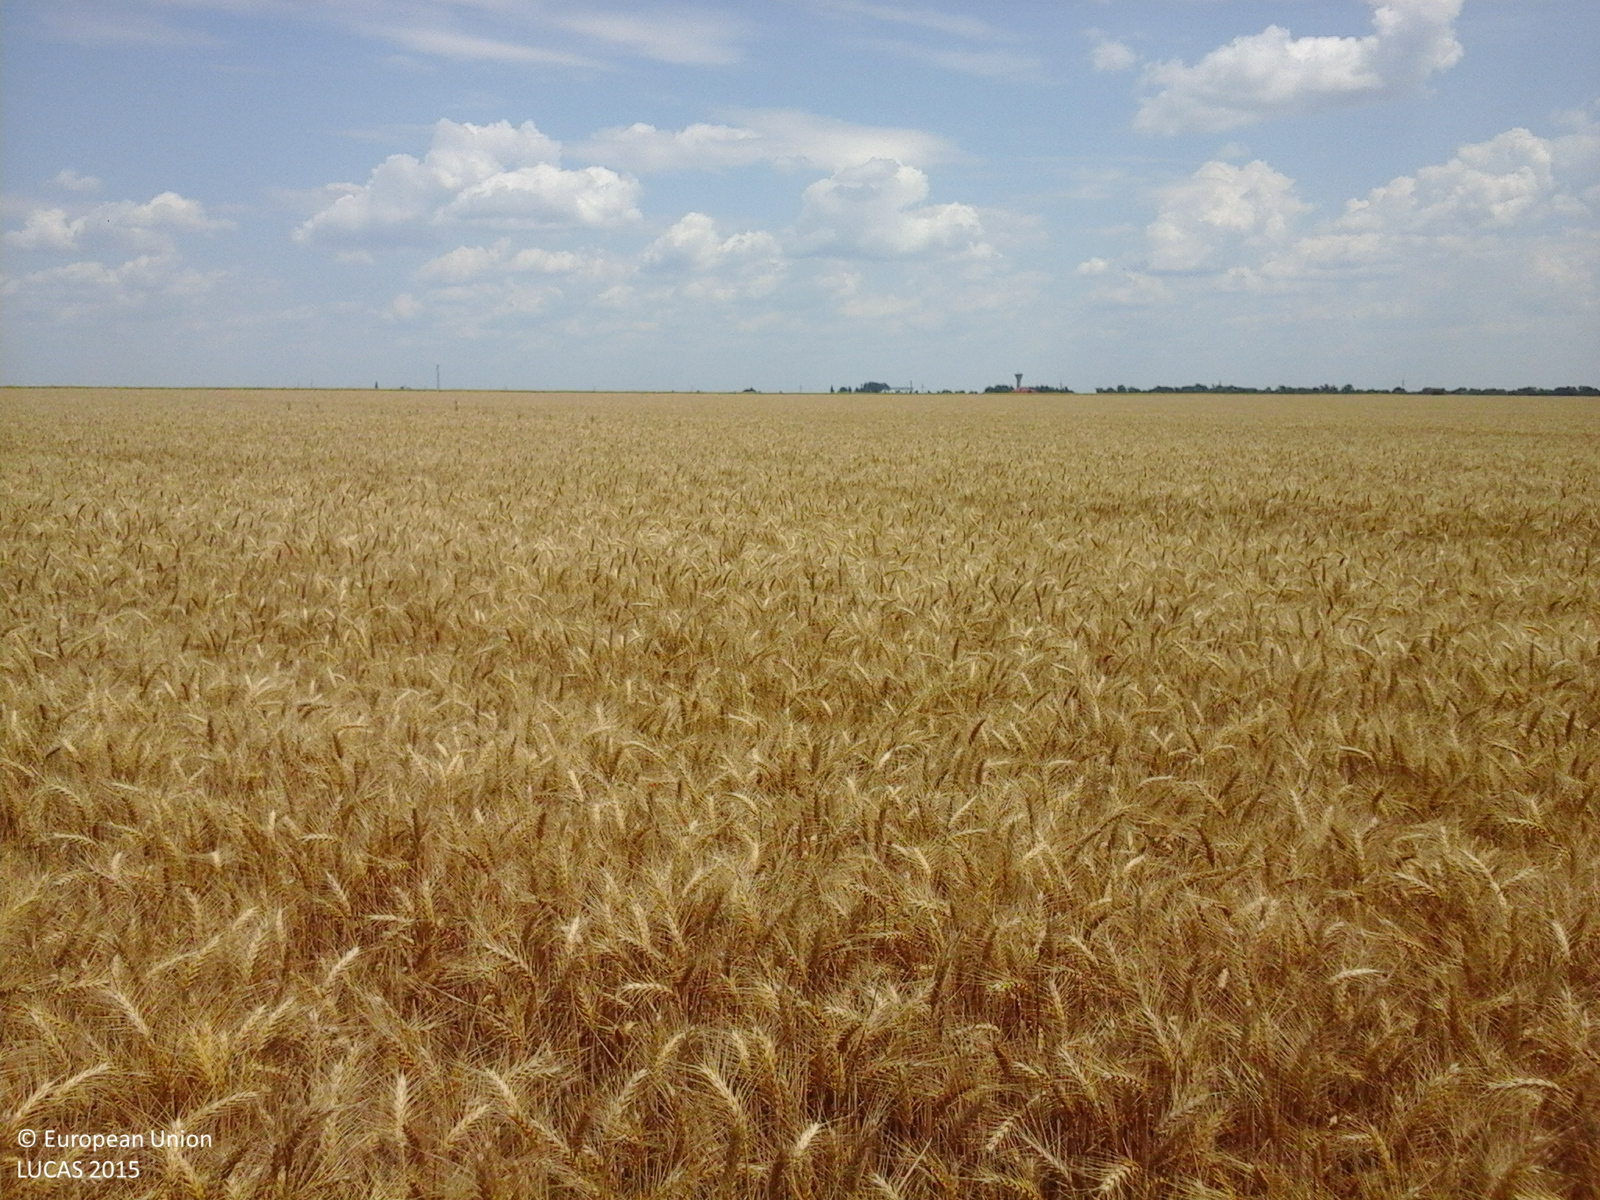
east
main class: Cropland
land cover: Common wheat
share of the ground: > 75 %
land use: Agriculture (excluding fallow land and kitchen gardens)
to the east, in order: Common wheat
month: June
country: RO
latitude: 44.2353
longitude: 26.0145
